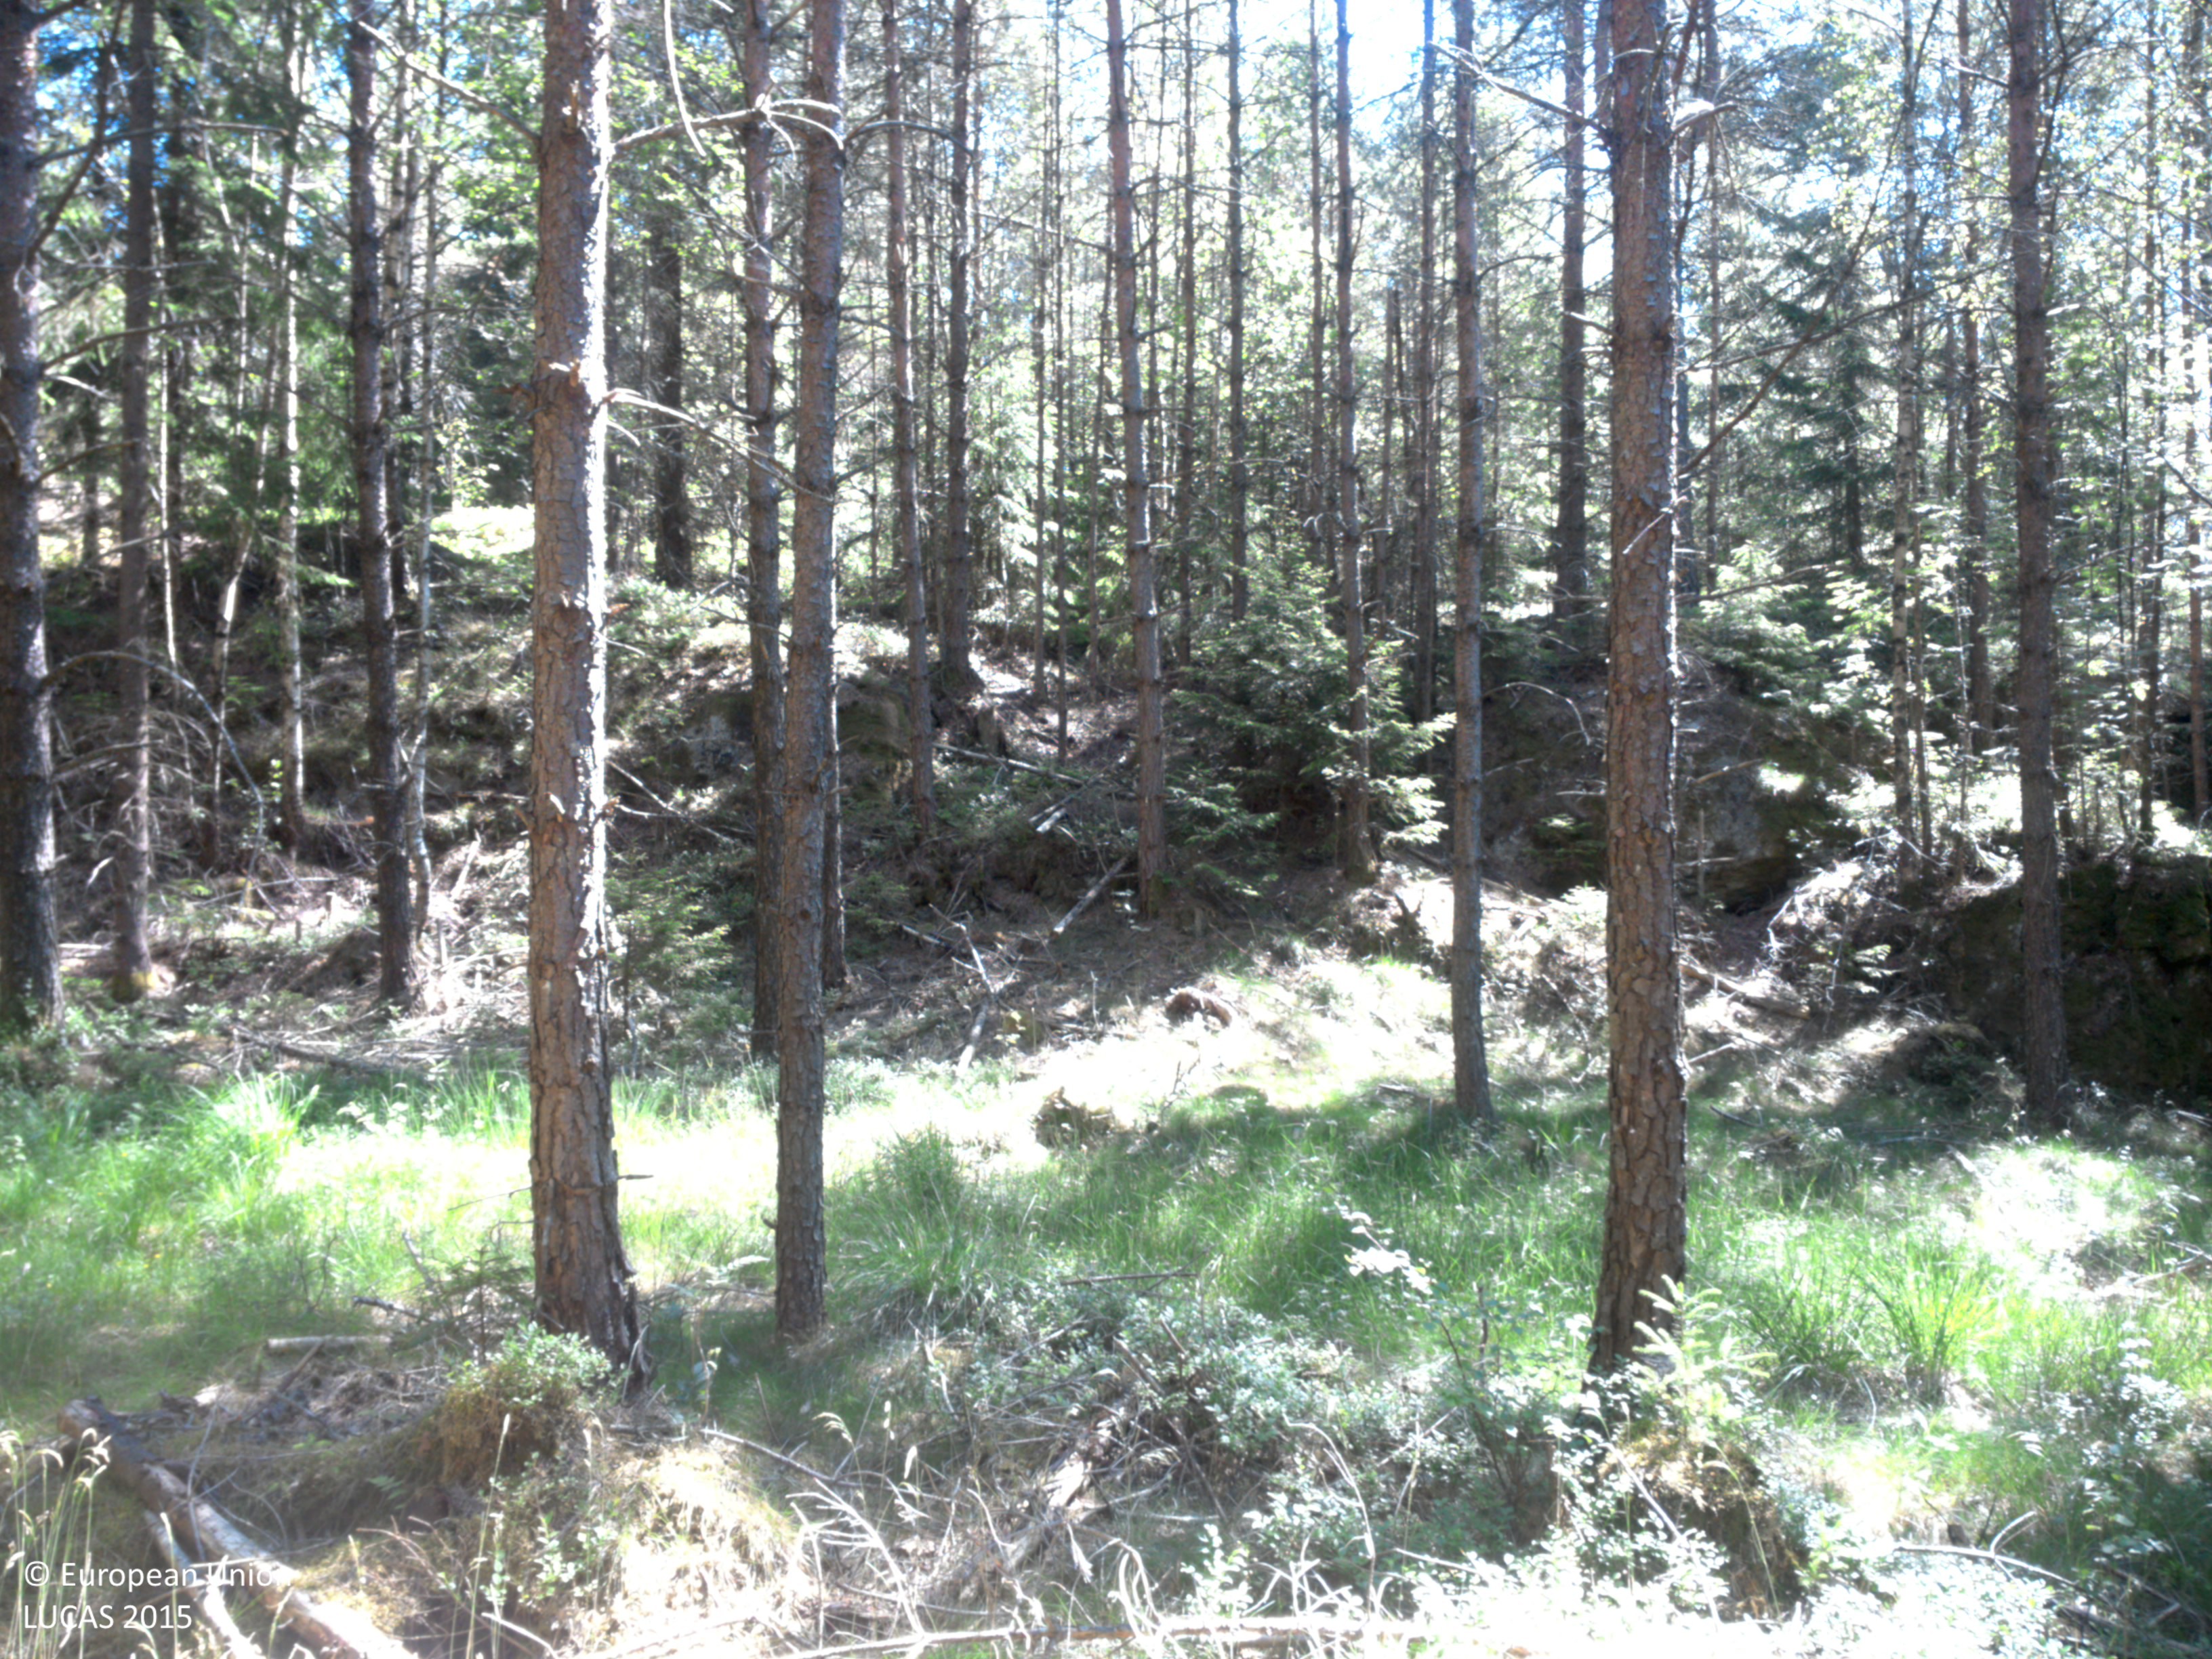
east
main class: Woodland
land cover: Other coniferous woodland
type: boreal forest
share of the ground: 50 - 75 %
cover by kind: coniferous forest trees 50 %, herbaceous plants 30 %, lichens and mosses 10 %, broadleaved forest trees 5 %, shrubs 5 %
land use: Forestry
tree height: > 5 m
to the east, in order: Other coniferous woodland; Pine dominated coniferous woodland; Tracks; Pine dominated coniferous woodland; Spruce dominated mixed woodland; Dry stone walls; Spruce dominated coniferous woodland; Ditches and canals; Grassland without tree/shrub cover; Ditches and canals; Pine dominated mixed woodland; Broadleaved woodland
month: July
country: SE
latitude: 58.5124
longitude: 11.8671
